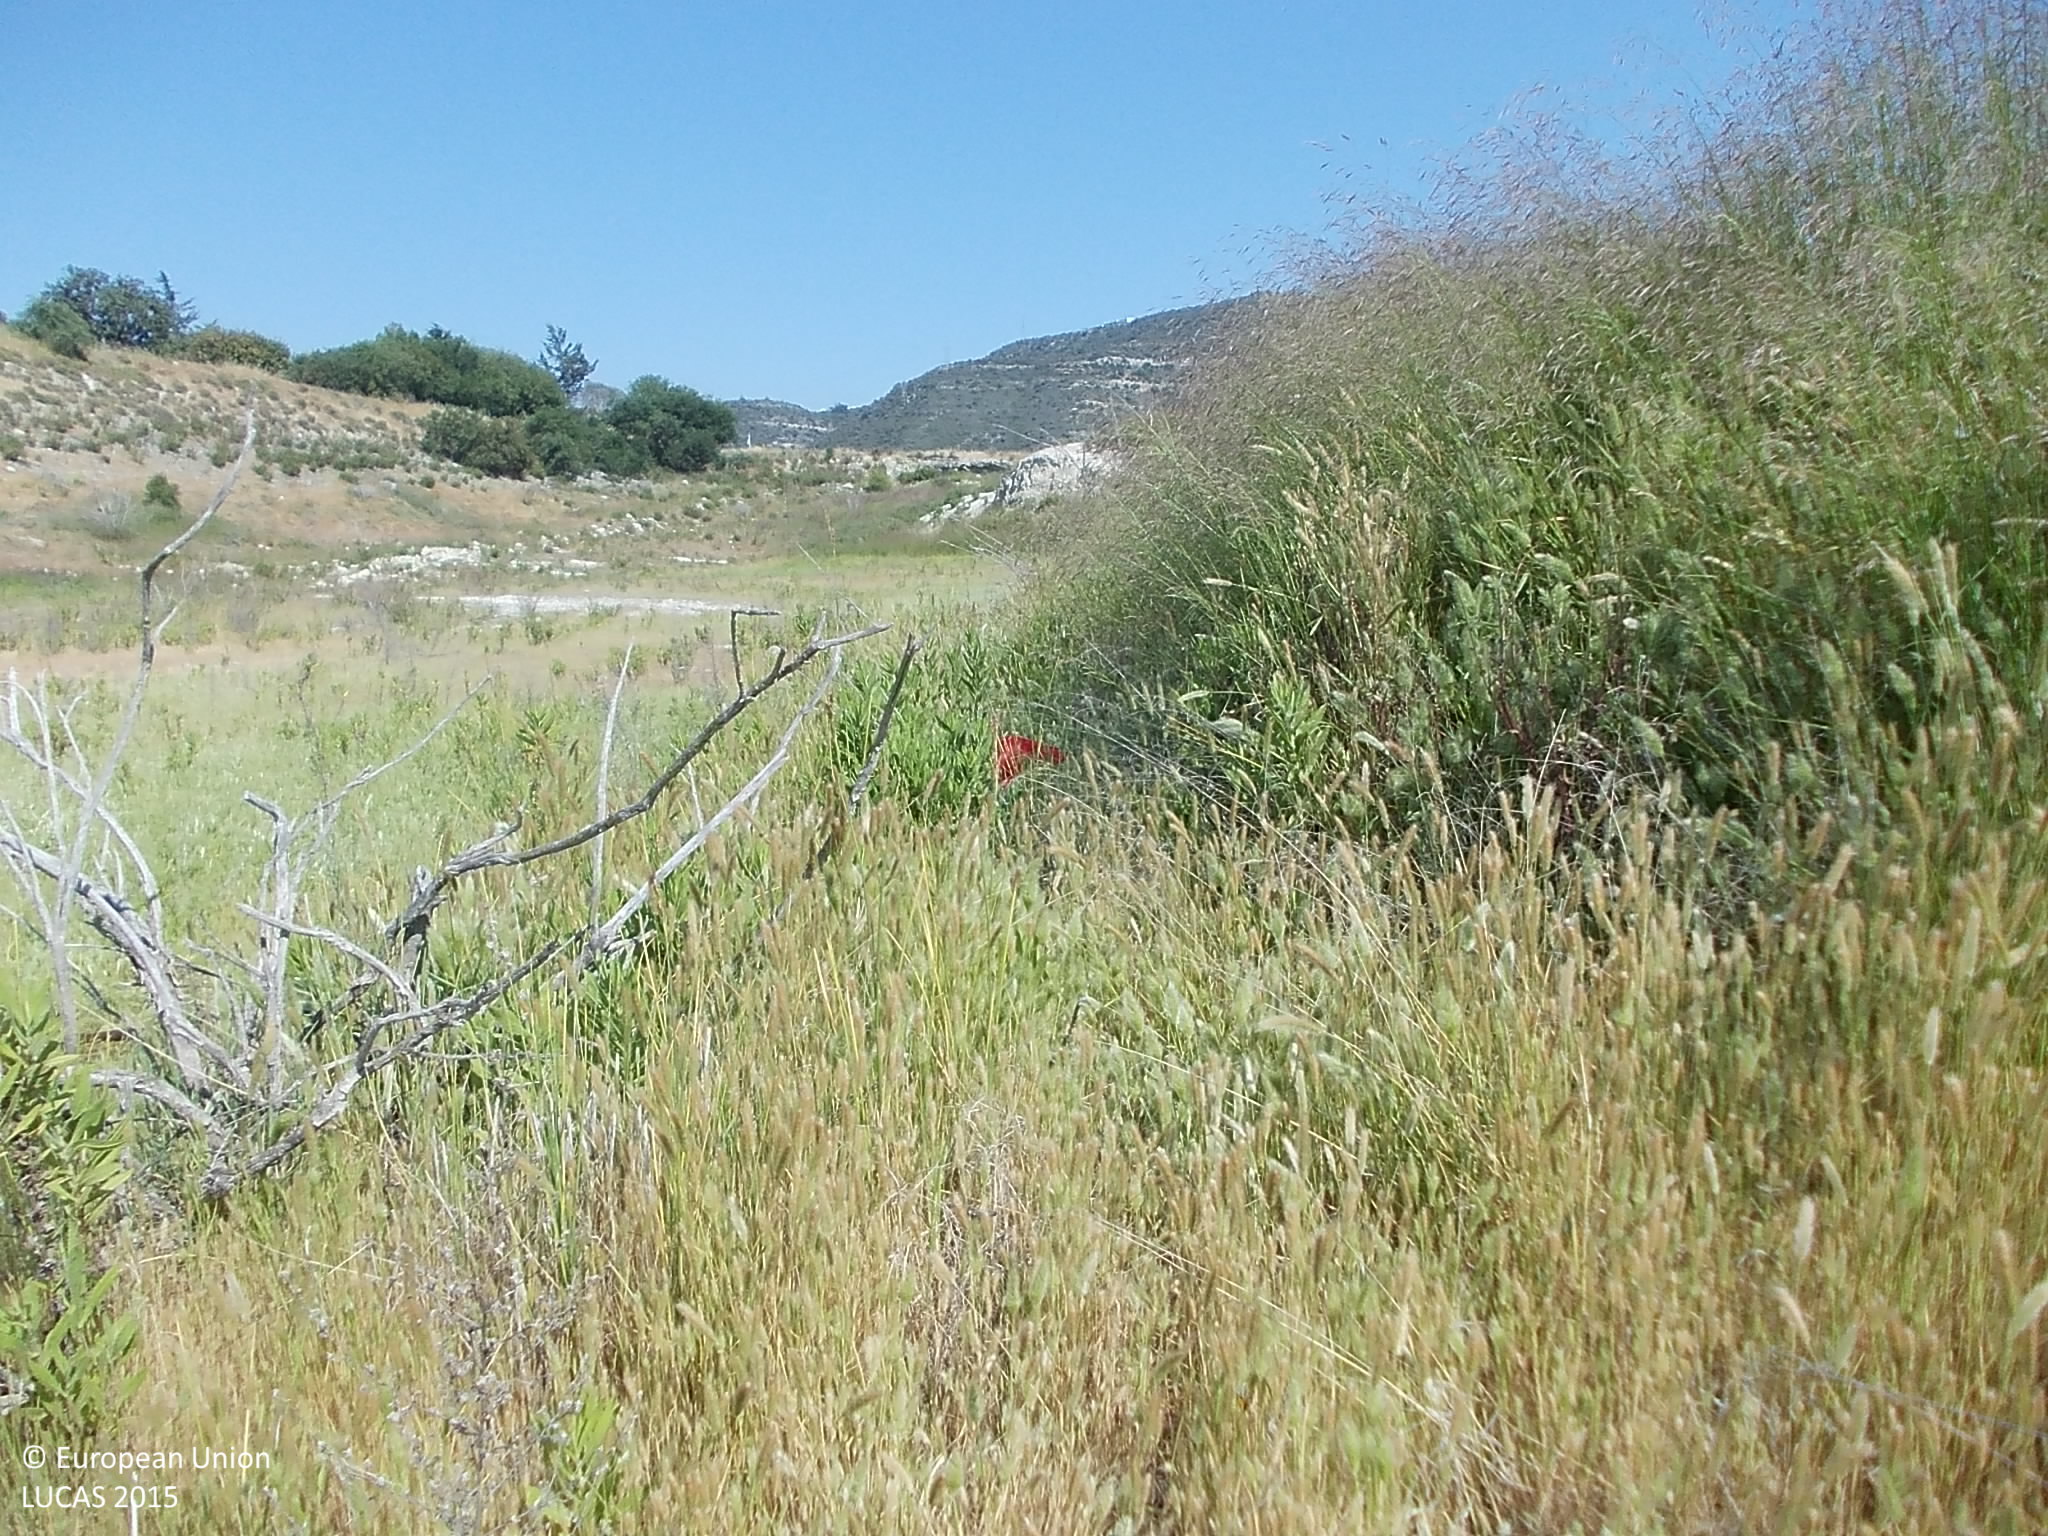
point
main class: Grassland
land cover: Grassland without tree/shrub cover
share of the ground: > 75 %
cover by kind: herbaceous plants 75 %, unconsolidated bare surface 25 %
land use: Semi-natural and natural areas not in use
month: May
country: CY
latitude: 34.7584
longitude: 32.9189
